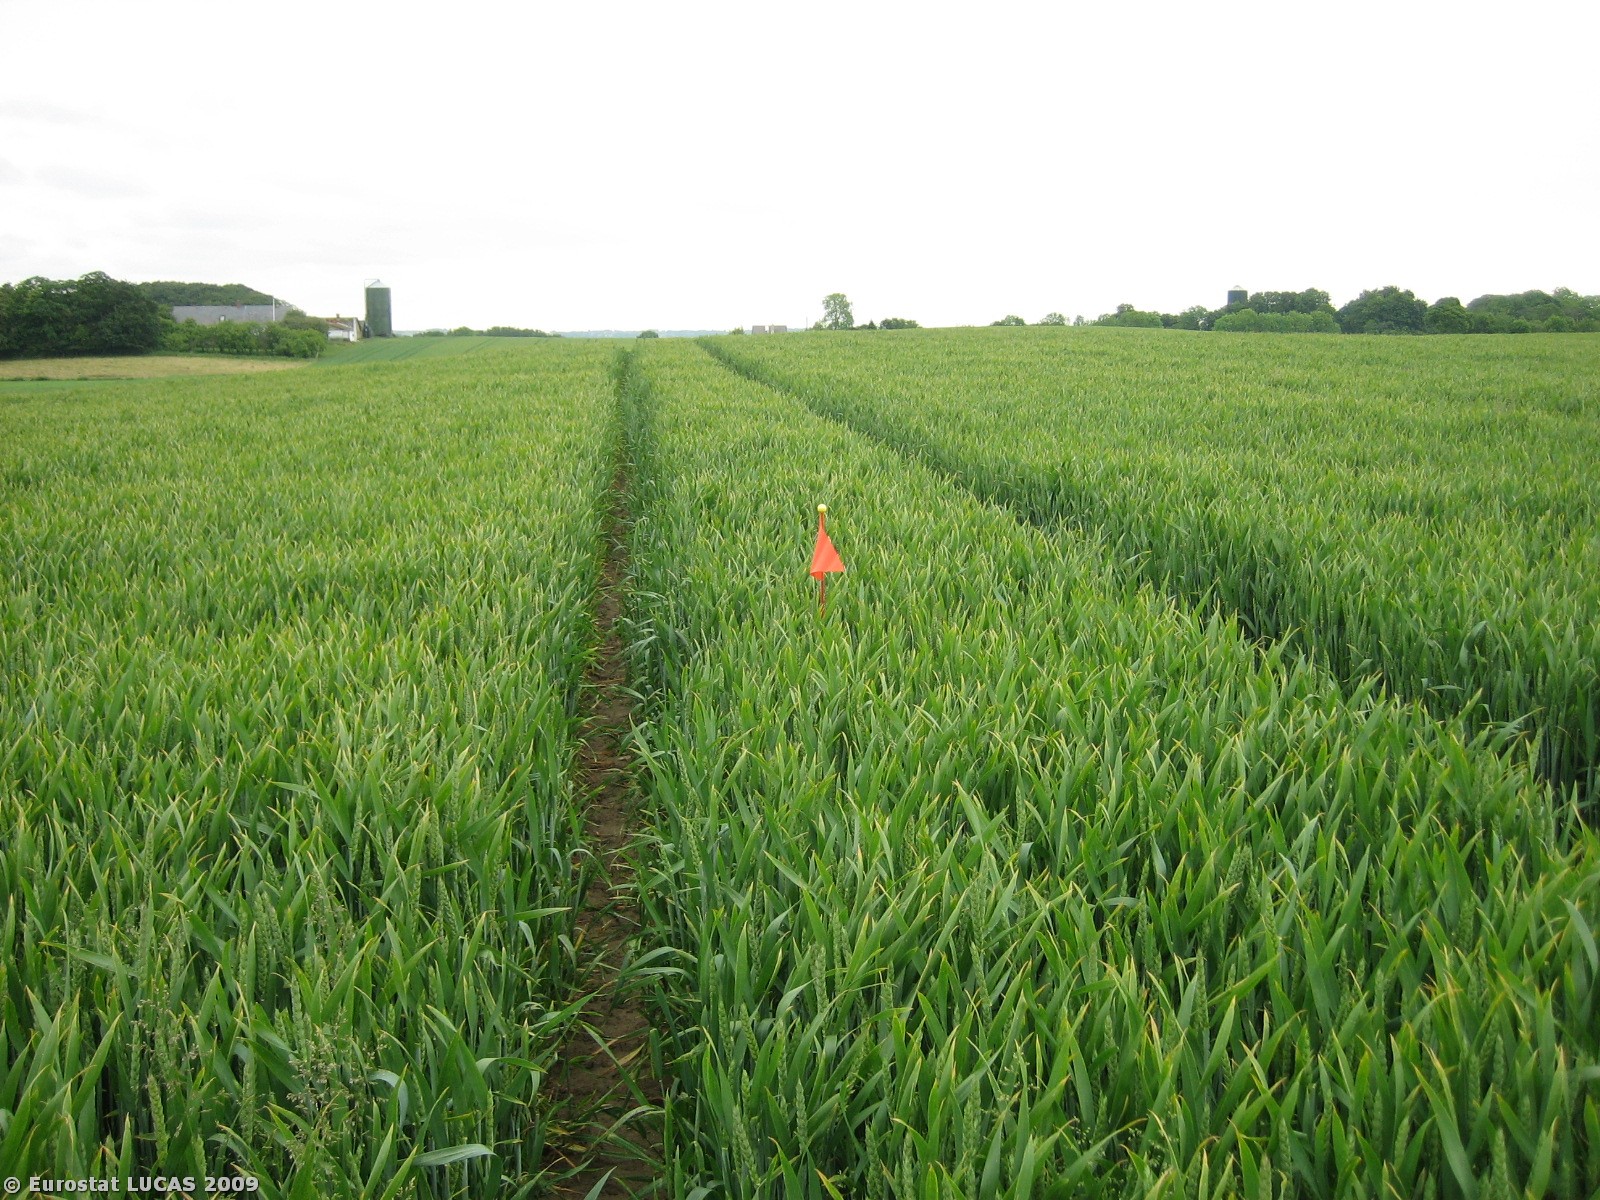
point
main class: Cropland
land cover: Common wheat
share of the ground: > 75 %
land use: Agriculture (excluding fallow land and kitchen gardens)
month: June
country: DK
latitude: 56.0438
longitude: 10.1443
